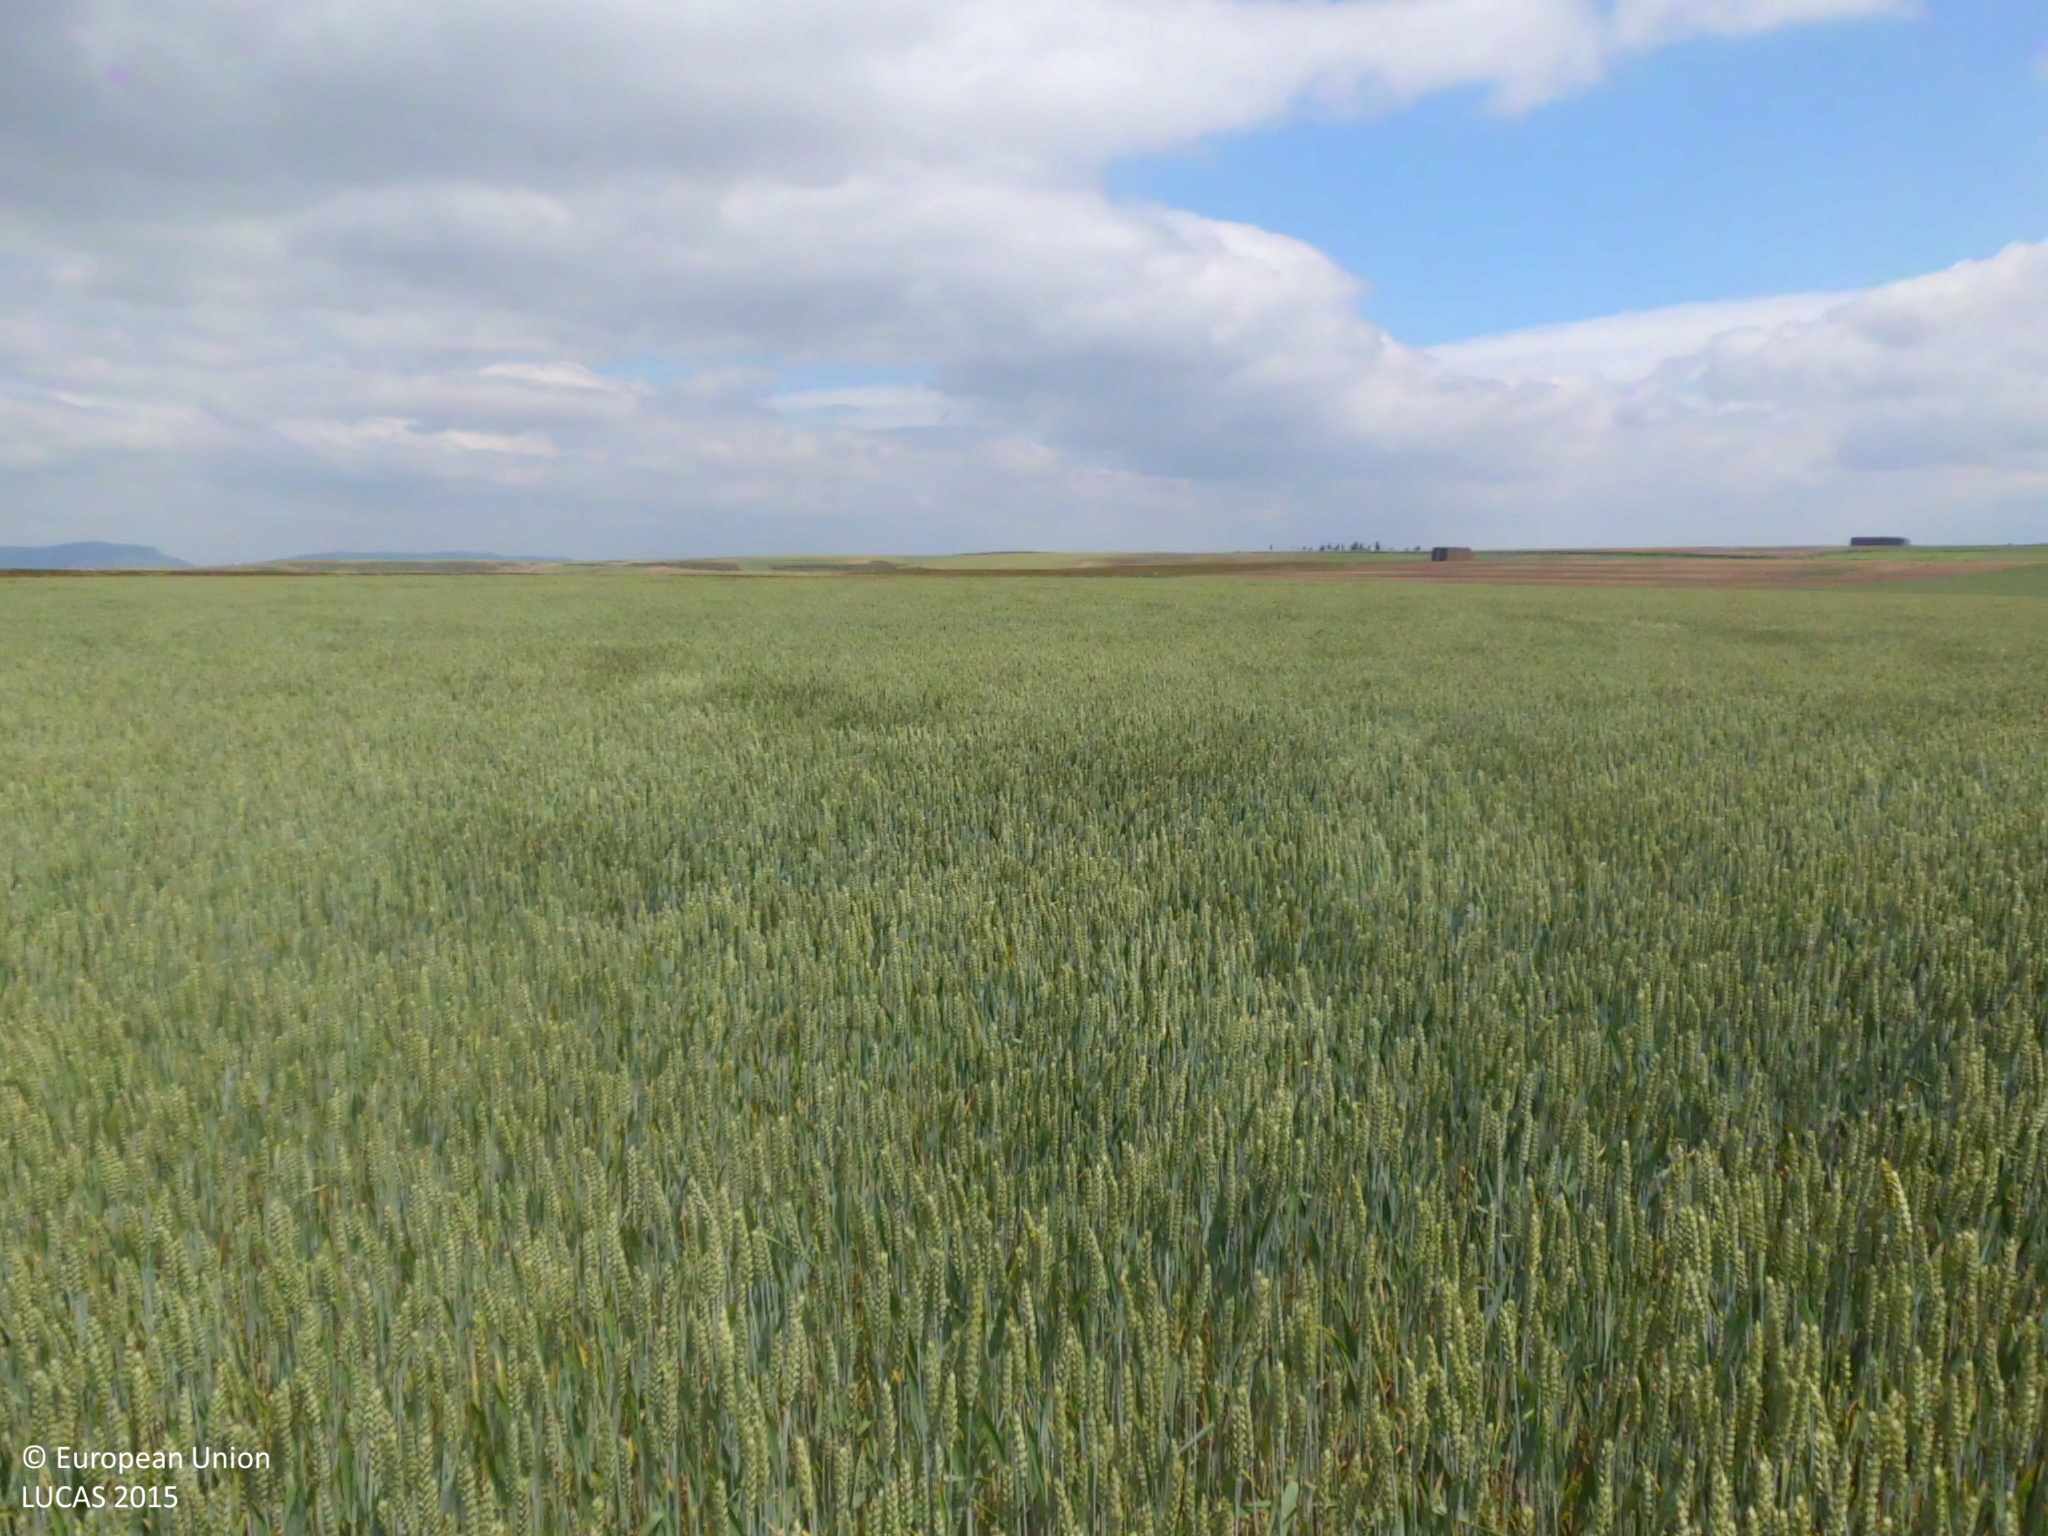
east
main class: Cropland
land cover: Common wheat
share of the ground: > 75 %
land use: Agriculture (excluding fallow land and kitchen gardens)
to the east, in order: Common wheat; Grass margins; Barley
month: June
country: ES
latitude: 42.5799
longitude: -3.2765
